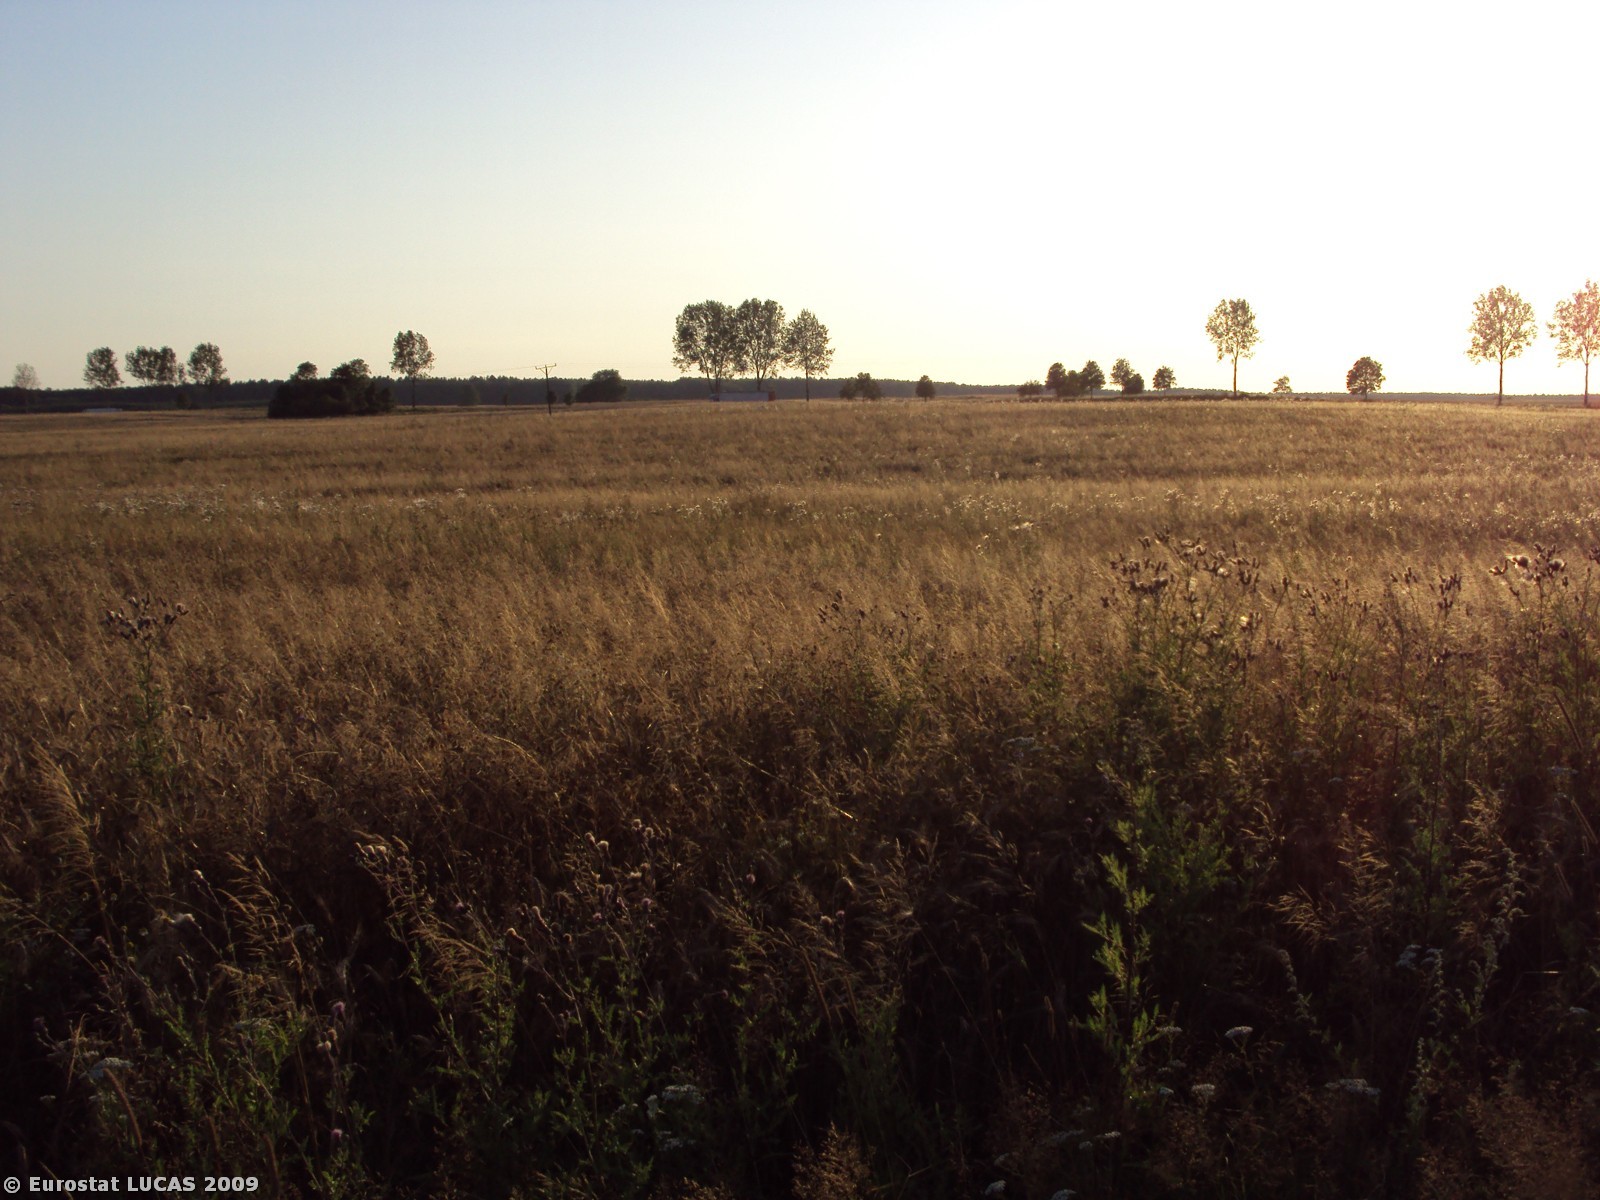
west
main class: Cropland
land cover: Triticale
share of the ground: > 75 %
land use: Agriculture (excluding fallow land and kitchen gardens)
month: August
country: PL
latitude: 53.3318
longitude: 16.5693
